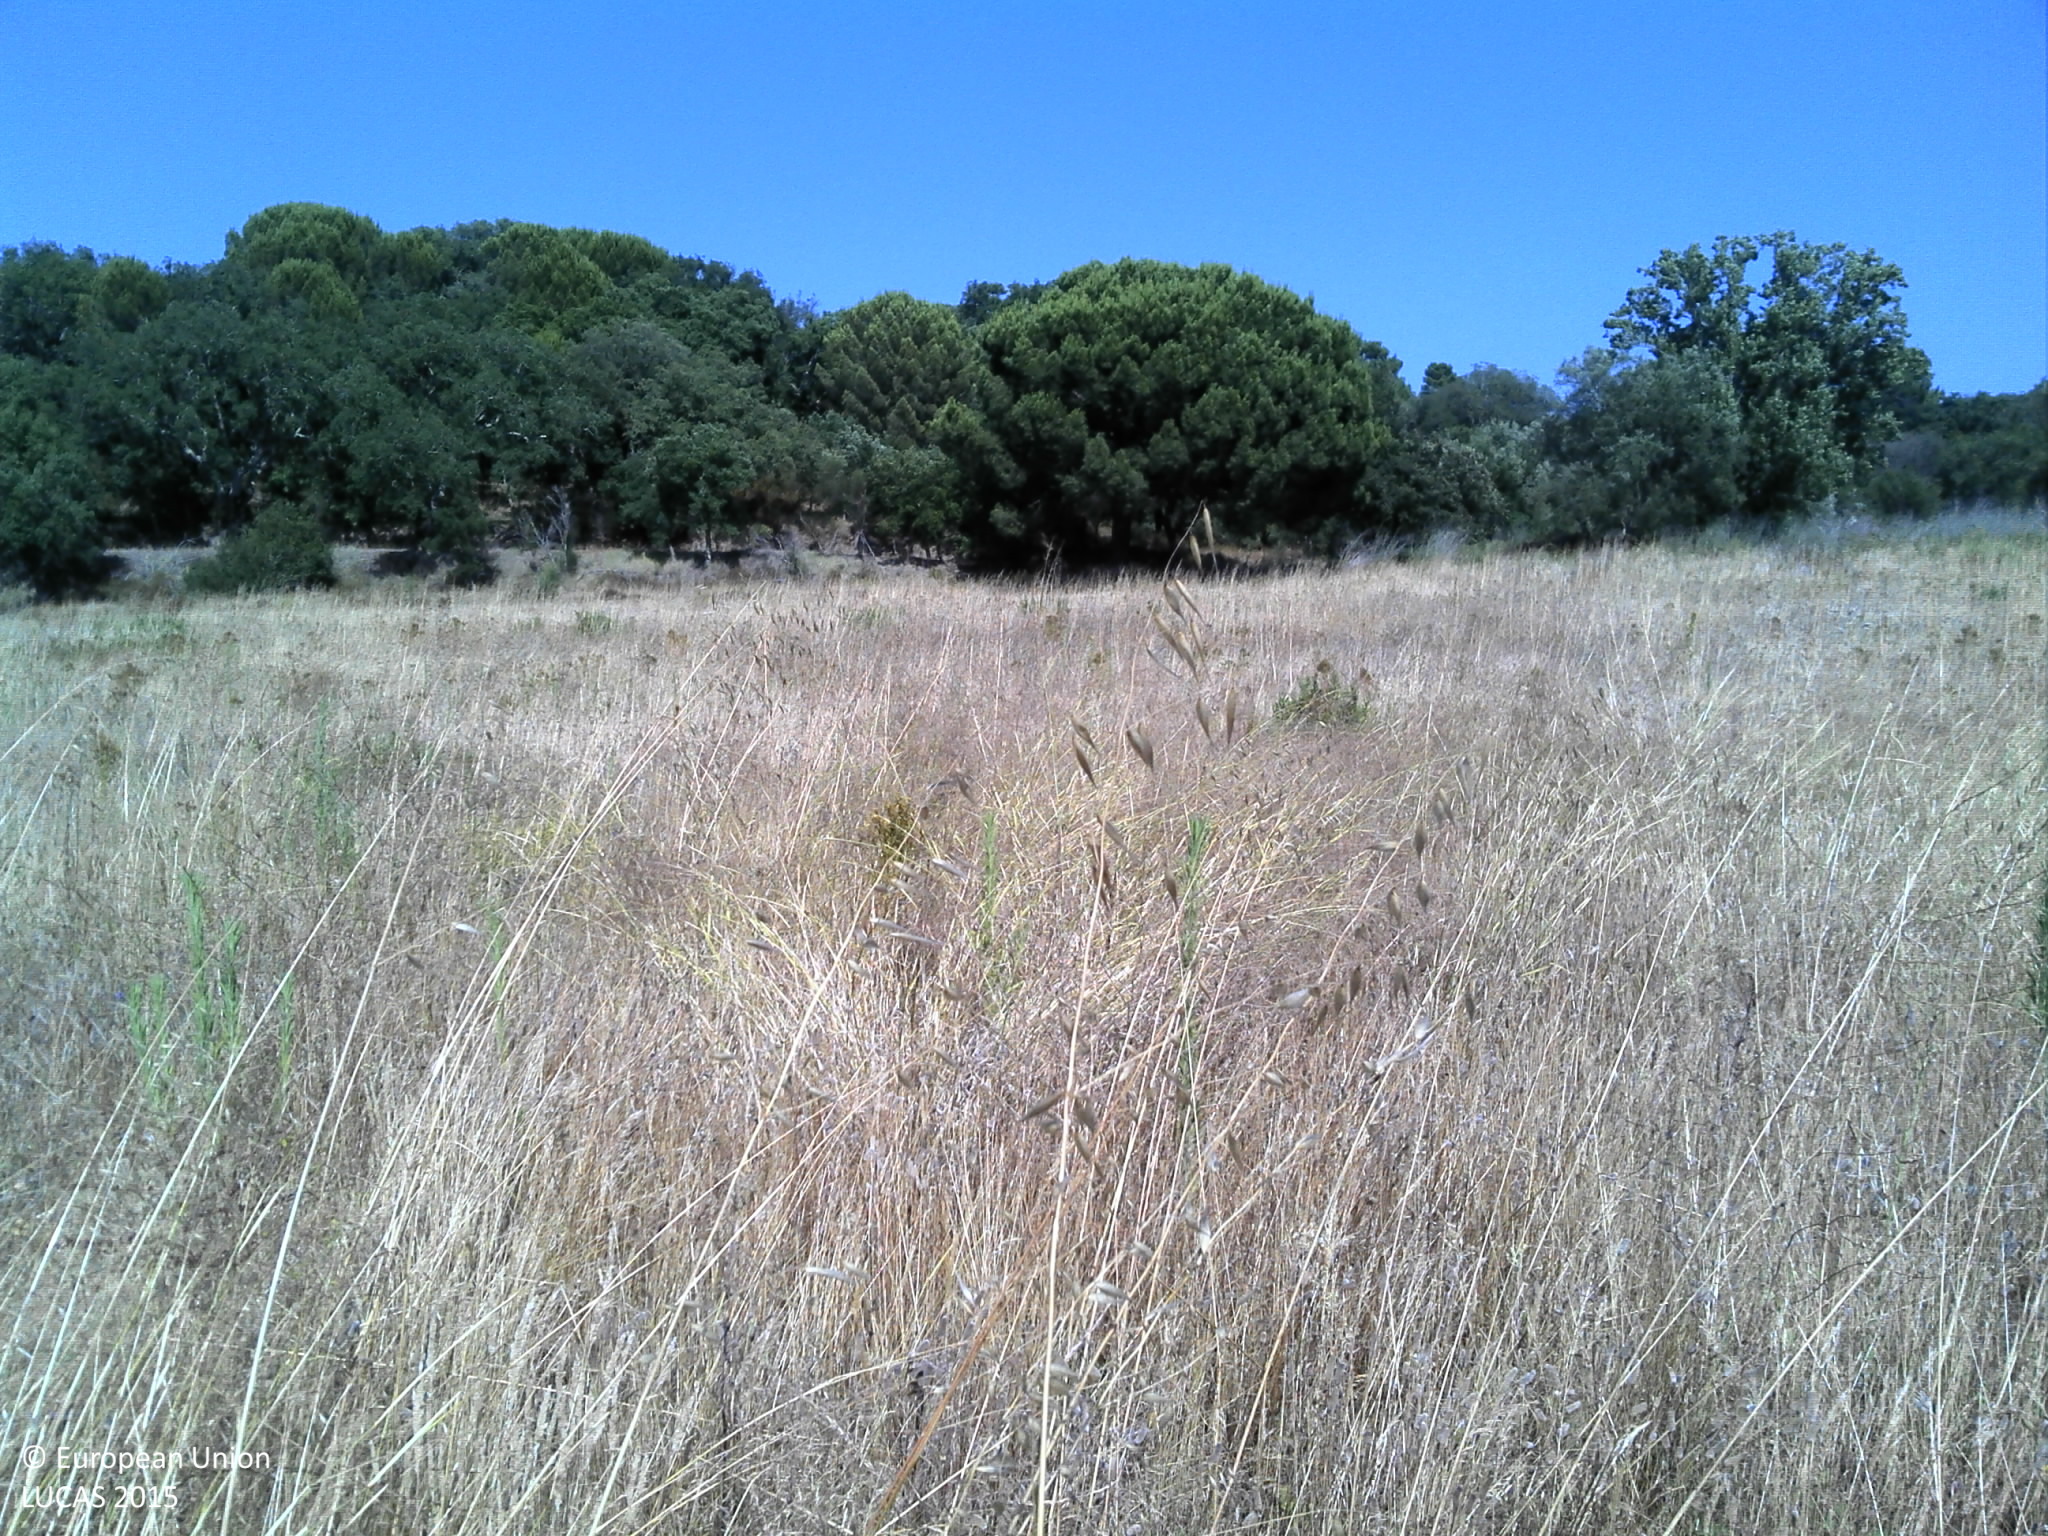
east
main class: Grassland
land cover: Spontaneously vegetated surfaces
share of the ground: 50 - 75 %
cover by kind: herbaceous plants 75 %, unconsolidated bare surface 25 %
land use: Fallow land
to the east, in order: Spontaneously vegetated surfaces; Ditches and canals; Broadleaved woodland; Tracks; Broadleaved woodland; Tracks; Broadleaved woodland
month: June
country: PT
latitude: 38.5112
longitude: -9.0481
